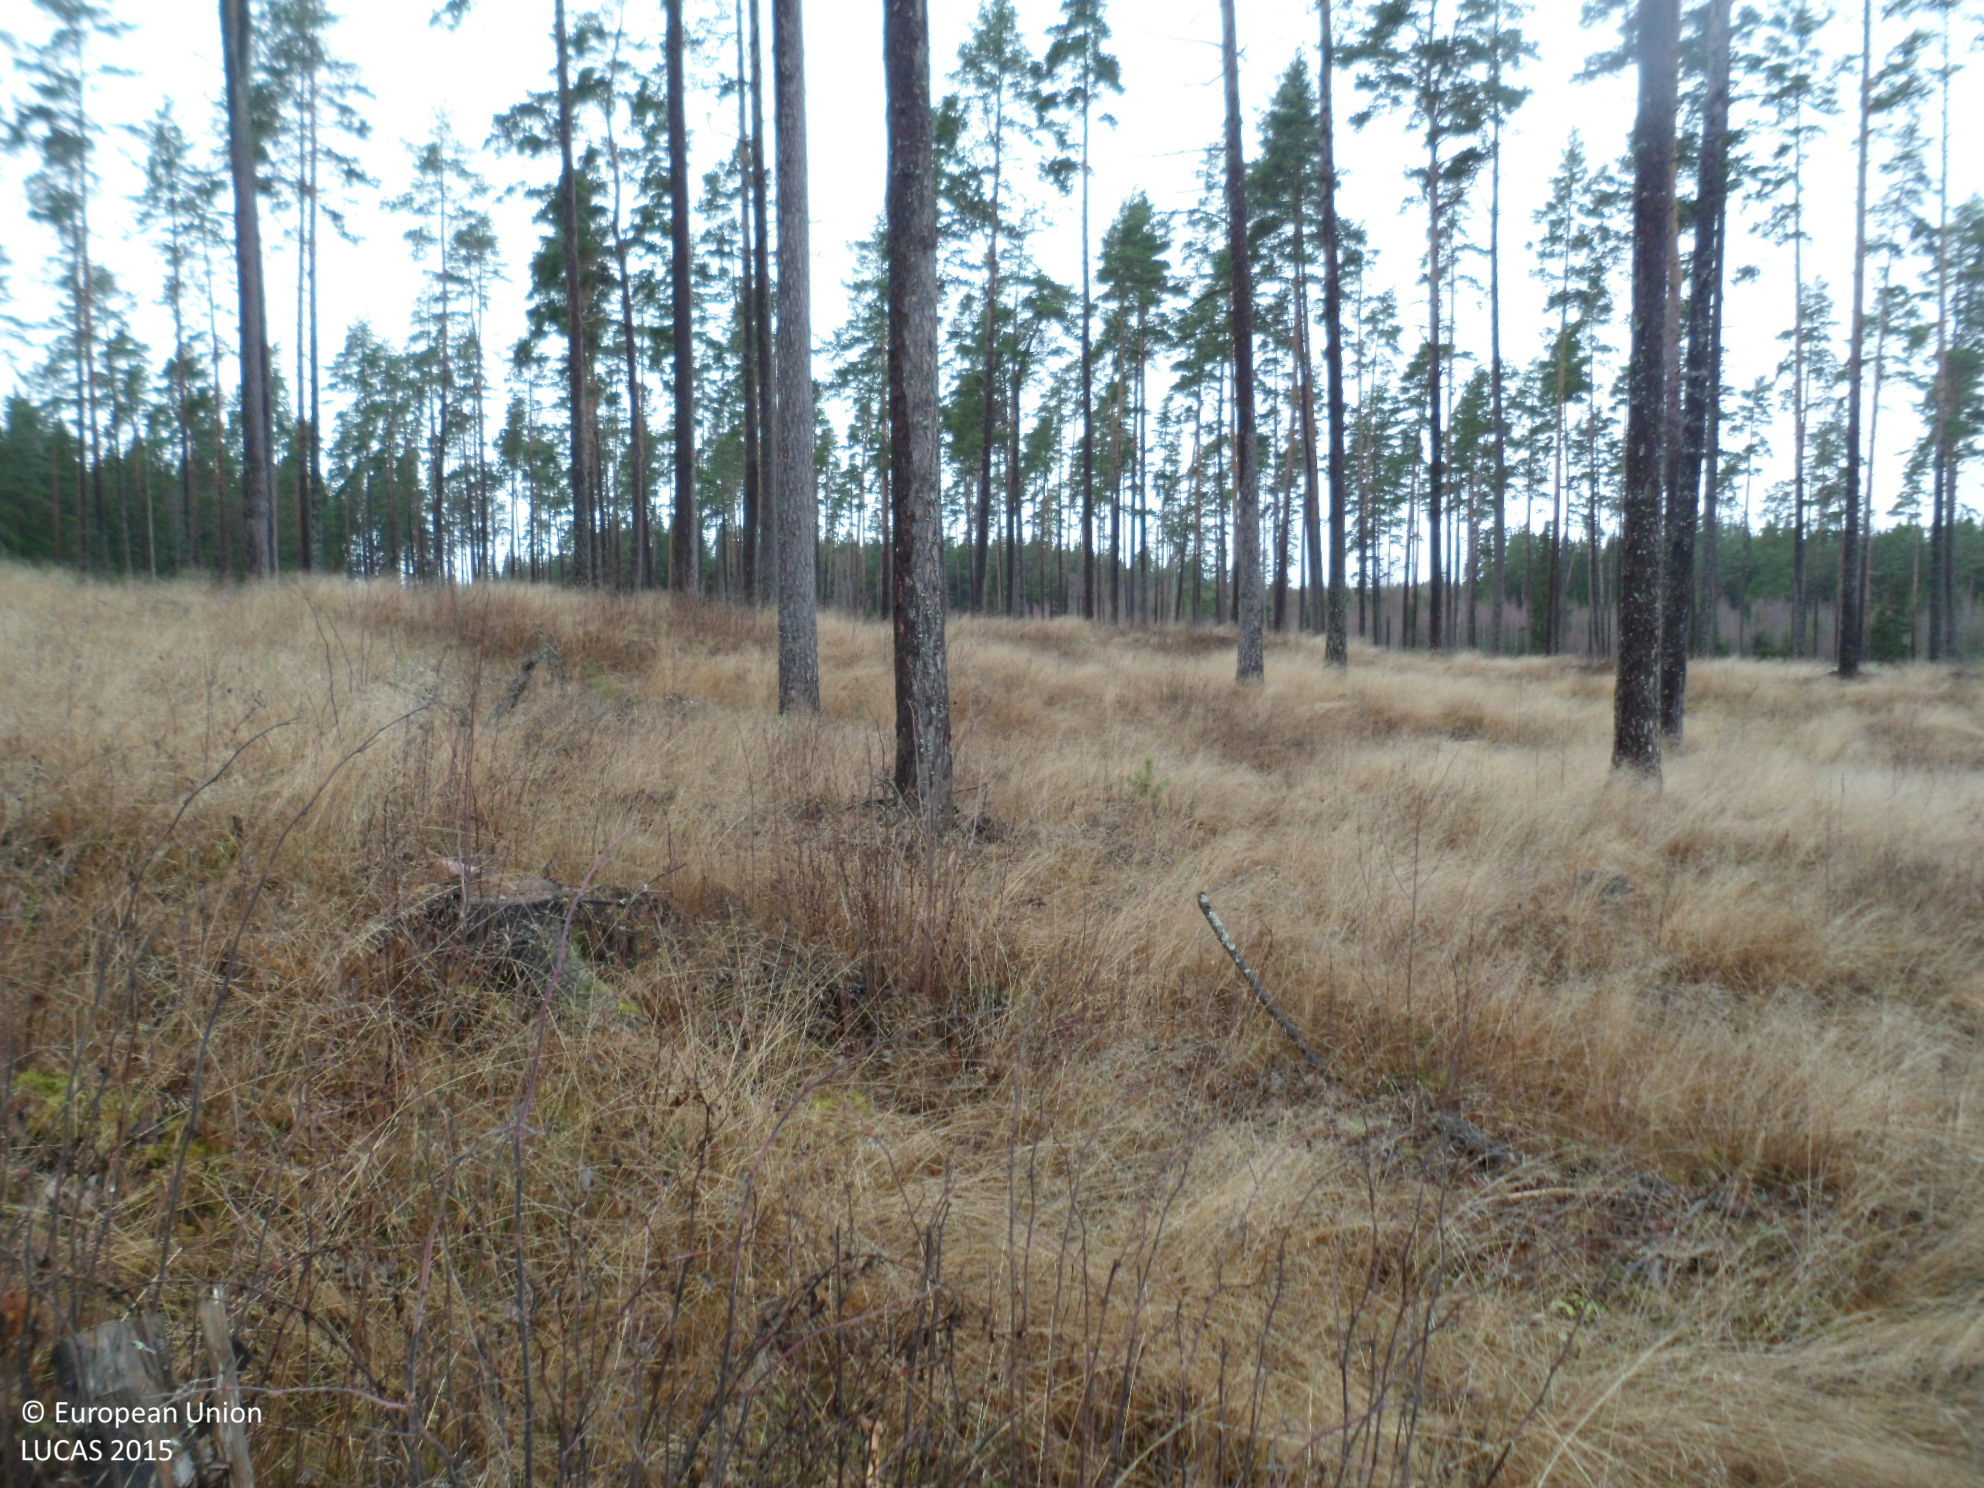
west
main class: Woodland
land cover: Pine dominated coniferous woodland
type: boreal forest
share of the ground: 25 - 50 %
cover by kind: herbaceous plants 40 %, coniferous forest trees 30 %, shrubs 20 %, broadleaved forest trees 5 %, lichens and mosses 5 %
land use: Forestry
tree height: > 5 m
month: November
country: SE
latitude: 57.7703
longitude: 14.8876
